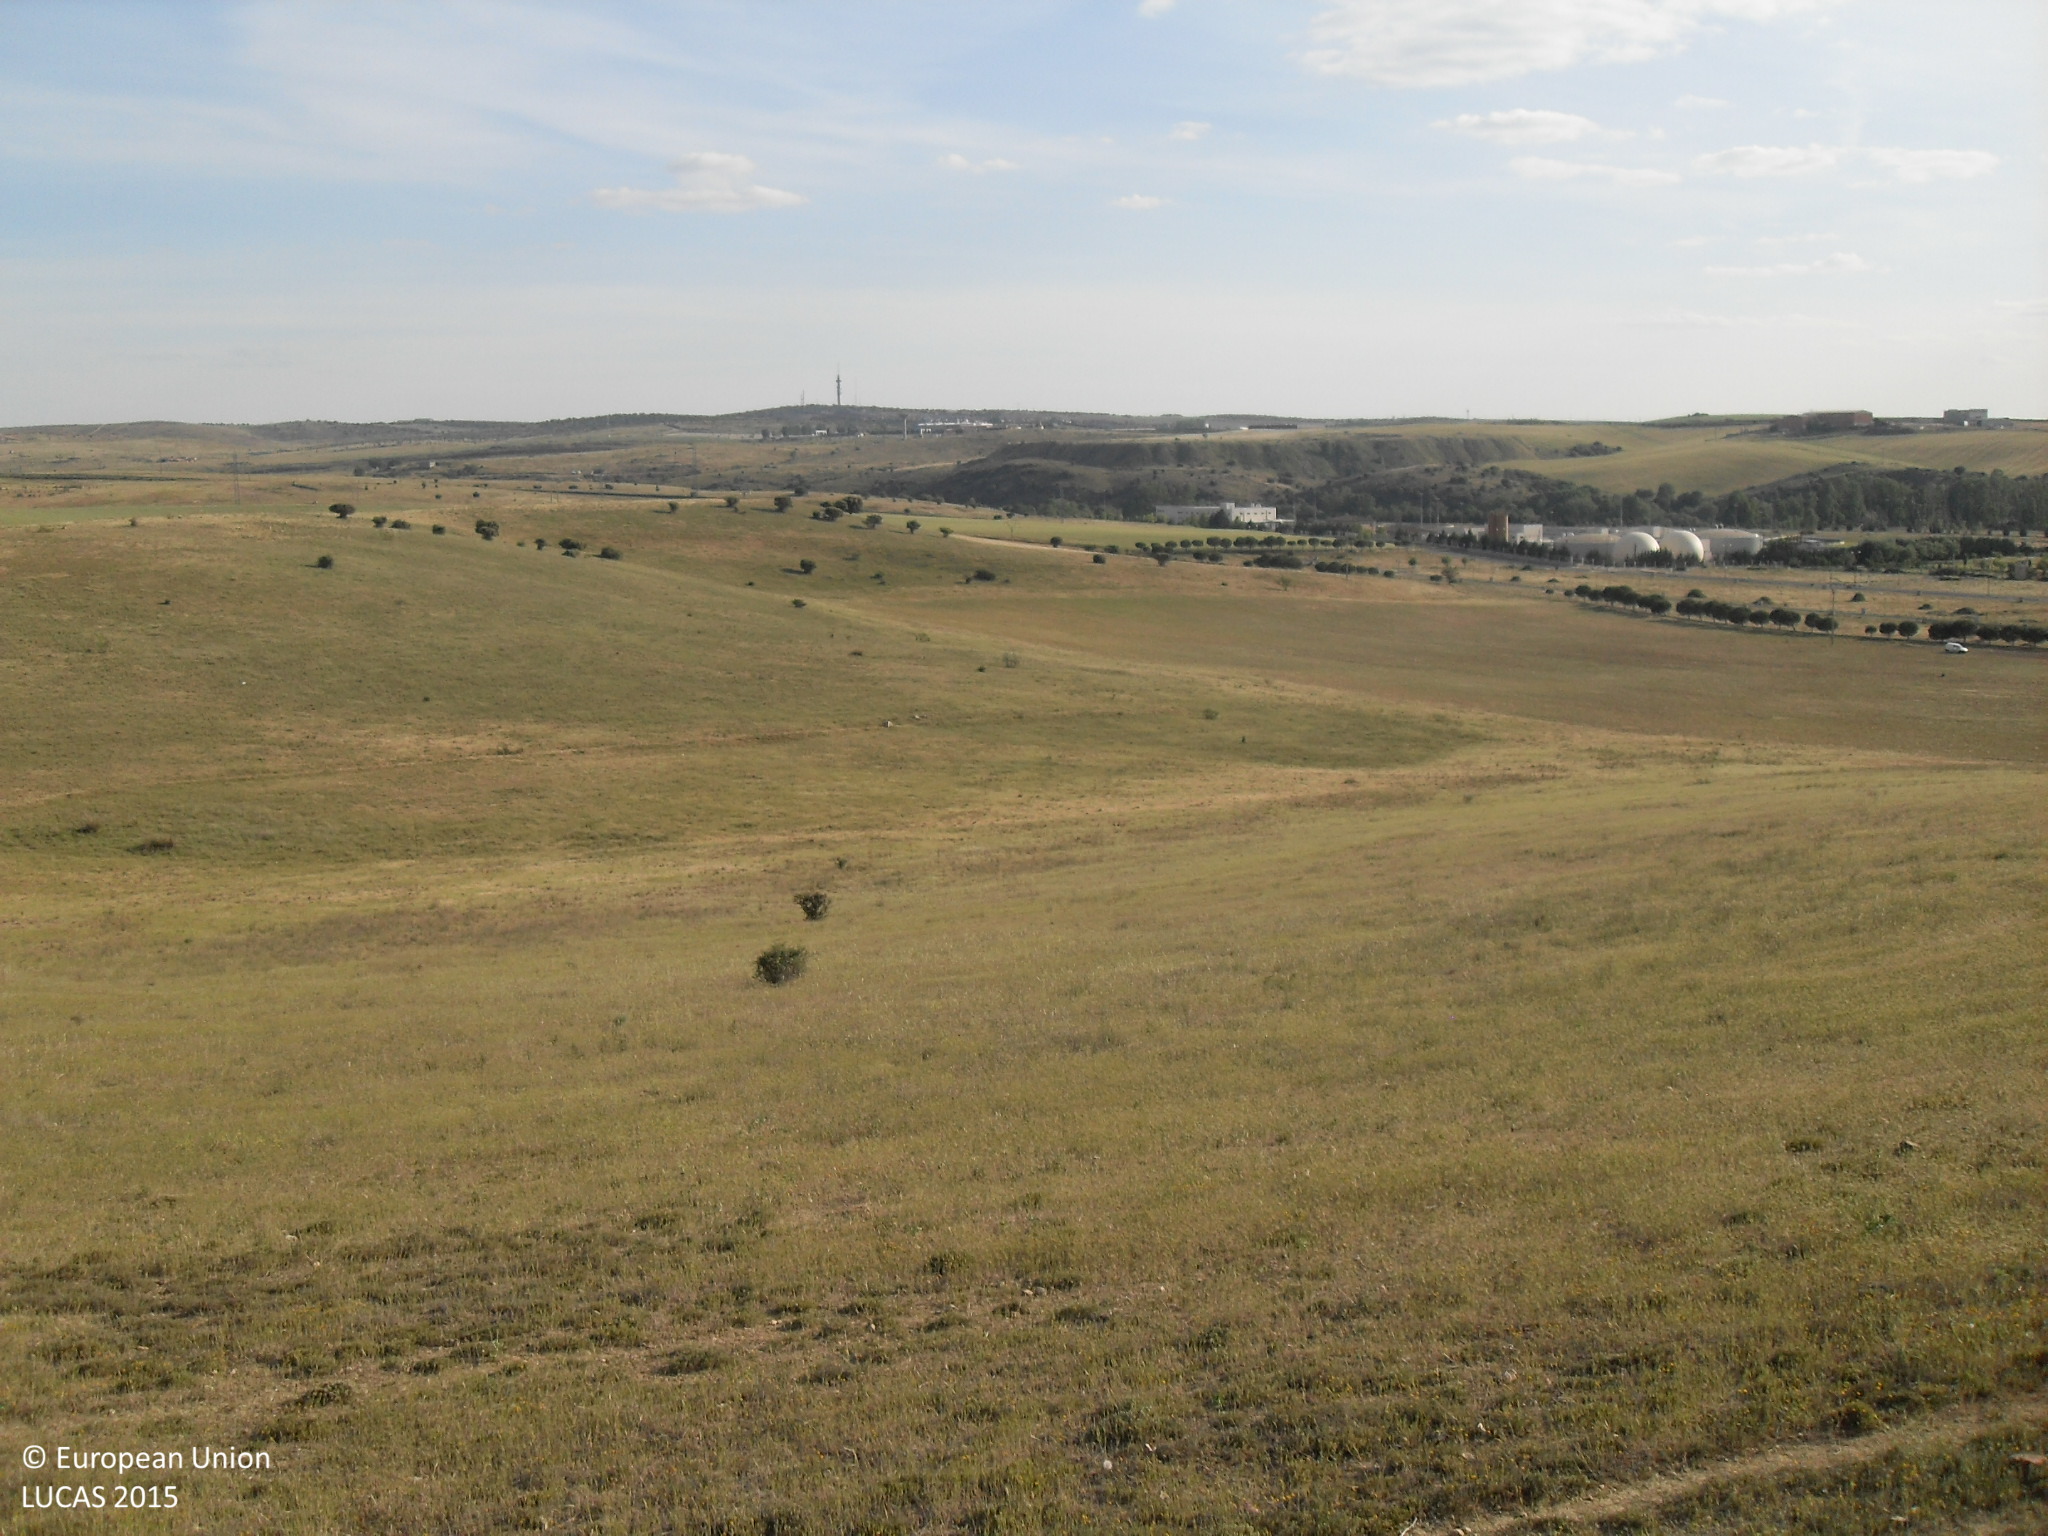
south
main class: Grassland
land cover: Grassland without tree/shrub cover
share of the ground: > 75 %
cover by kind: herbaceous plants 100 %
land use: Agriculture (excluding fallow land and kitchen gardens)
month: May
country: ES
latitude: 40.9788
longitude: -5.7066
